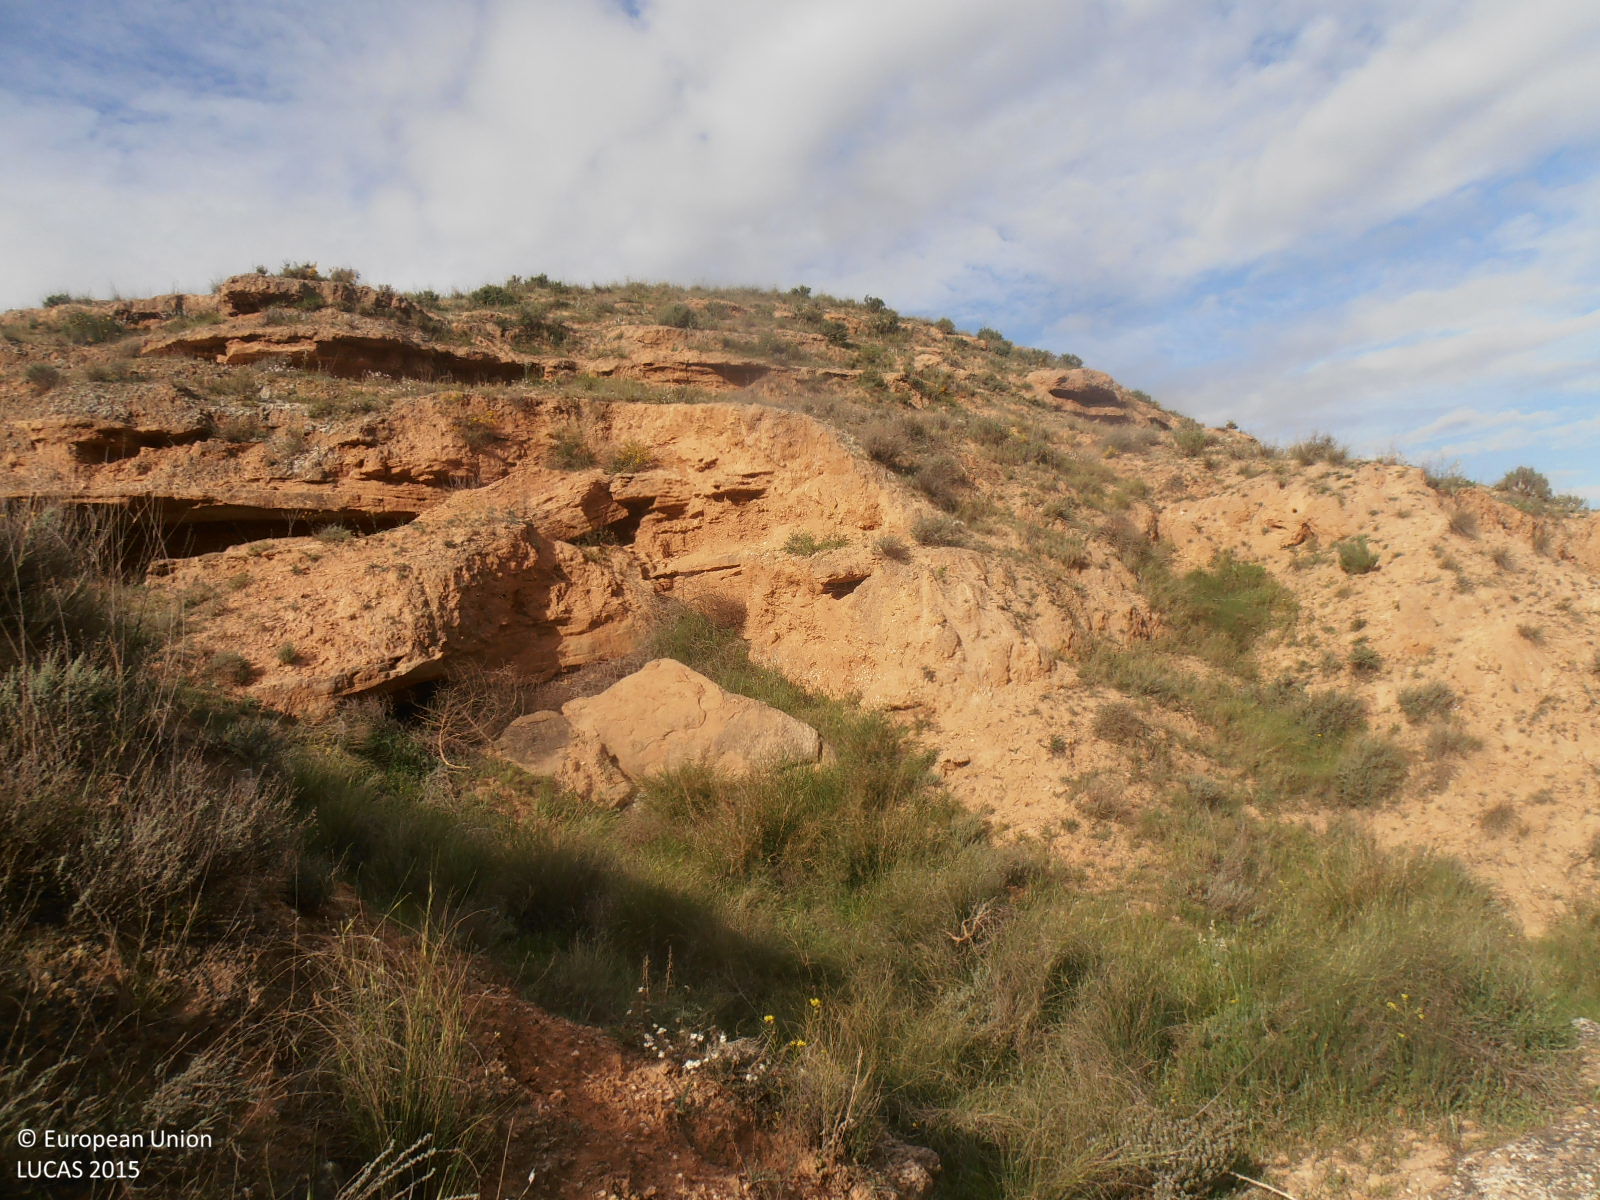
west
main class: Grassland
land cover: Grassland without tree/shrub cover
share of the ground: 50 - 75 %
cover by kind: herbaceous plants 60 %, consolidated bare surface 40 %
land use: Semi-natural and natural areas not in use
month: April
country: ES
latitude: 41.1915
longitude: -0.3752
